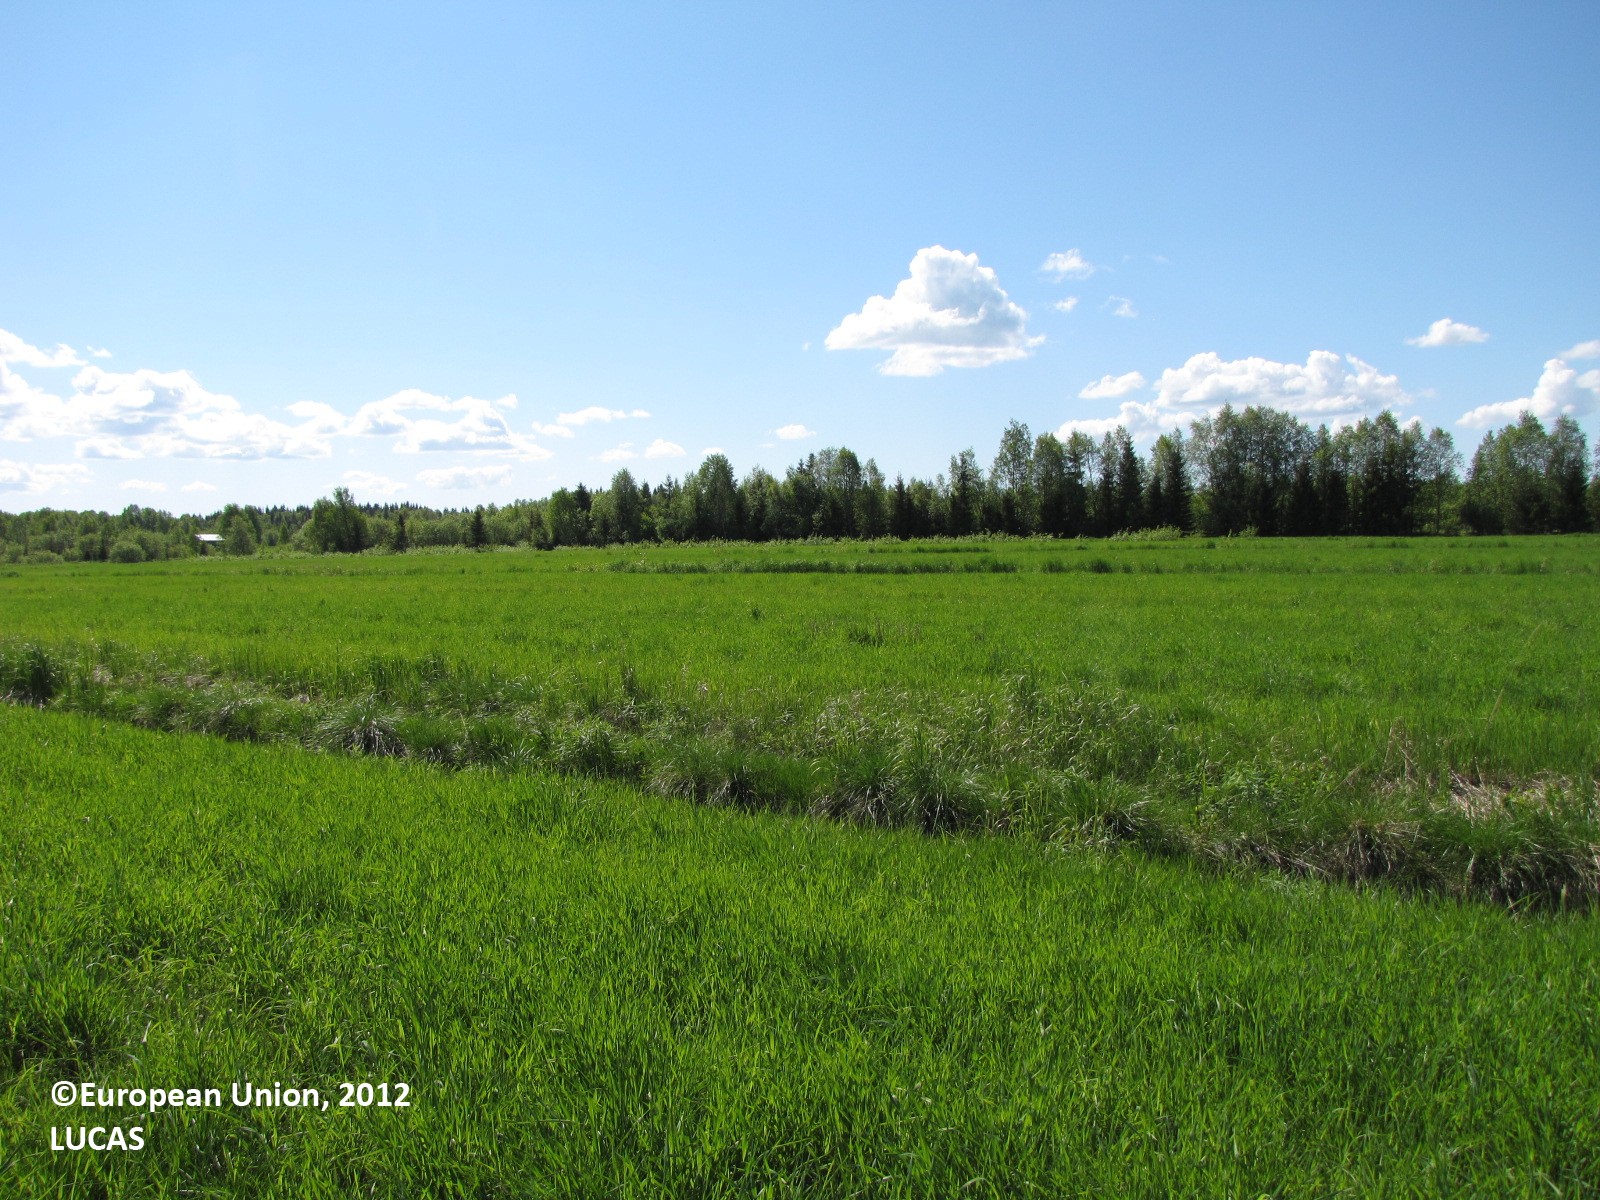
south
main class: Grassland
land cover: Grassland without tree/shrub cover
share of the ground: > 75 %
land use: Agriculture (excluding fallow land and kitchen gardens)
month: June
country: FI
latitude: 66.0108
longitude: 24.7582
